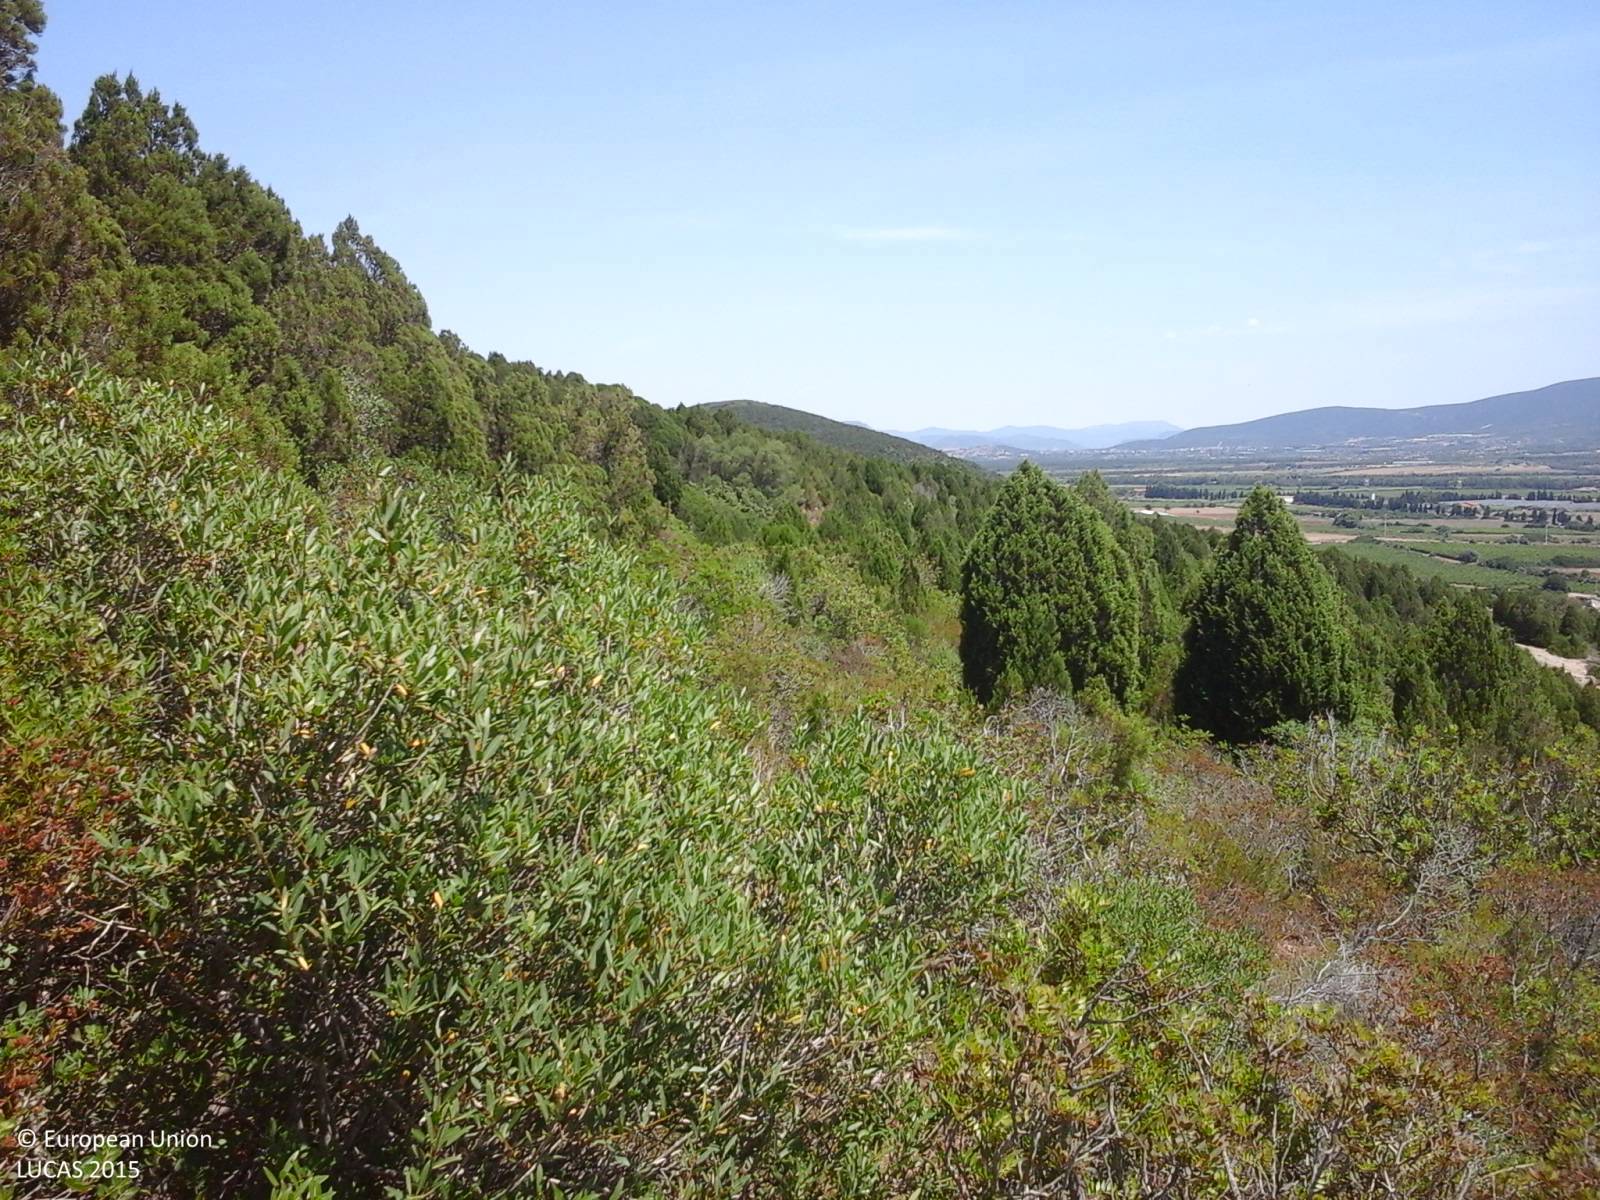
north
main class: Woodland
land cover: Other coniferous woodland
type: coniferous forest of the mediterranean region
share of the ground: > 75 %
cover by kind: coniferous forest trees 70 %, shrubs 15 %, herbaceous plants 10 %, unconsolidated bare surface 5 %
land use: Forestry
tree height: < 5 m
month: June
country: IT
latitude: 38.9890
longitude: 8.5890
